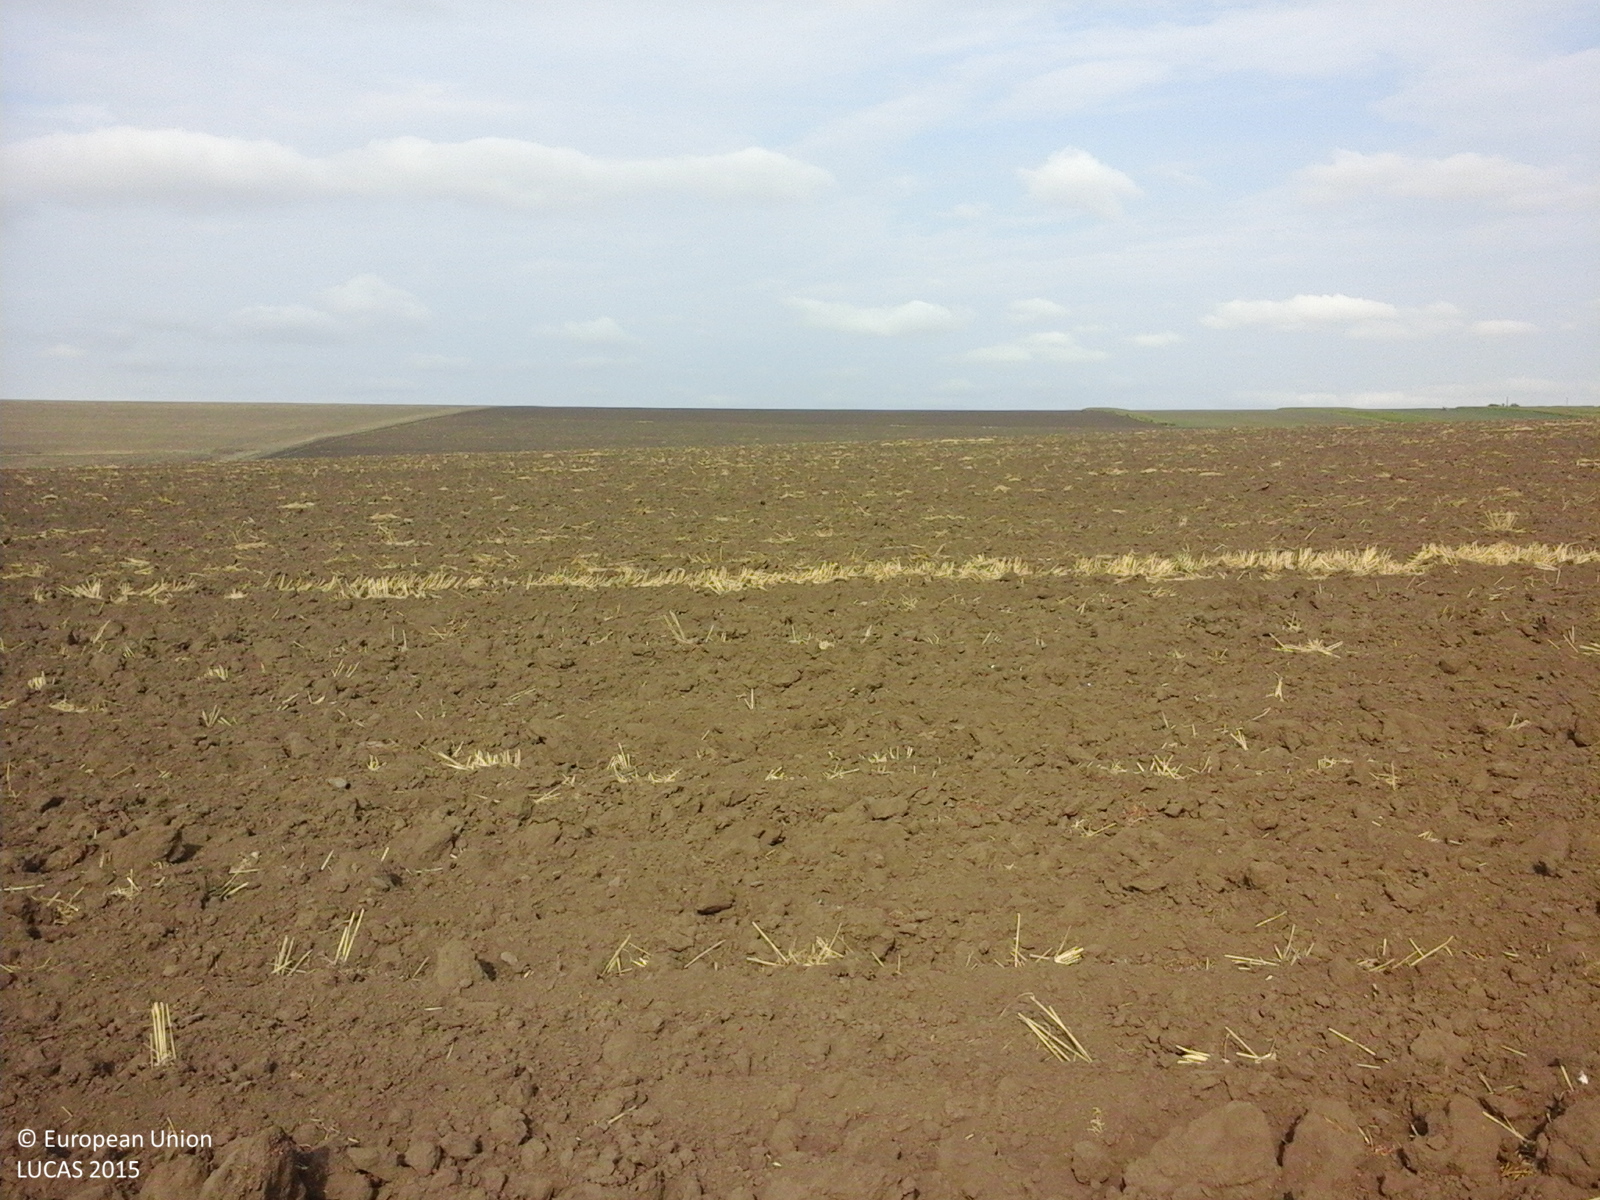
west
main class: Cropland
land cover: Common wheat
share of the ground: < 10 %
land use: Agriculture (excluding fallow land and kitchen gardens)
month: August
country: RO
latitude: 45.1014
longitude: 28.8352
